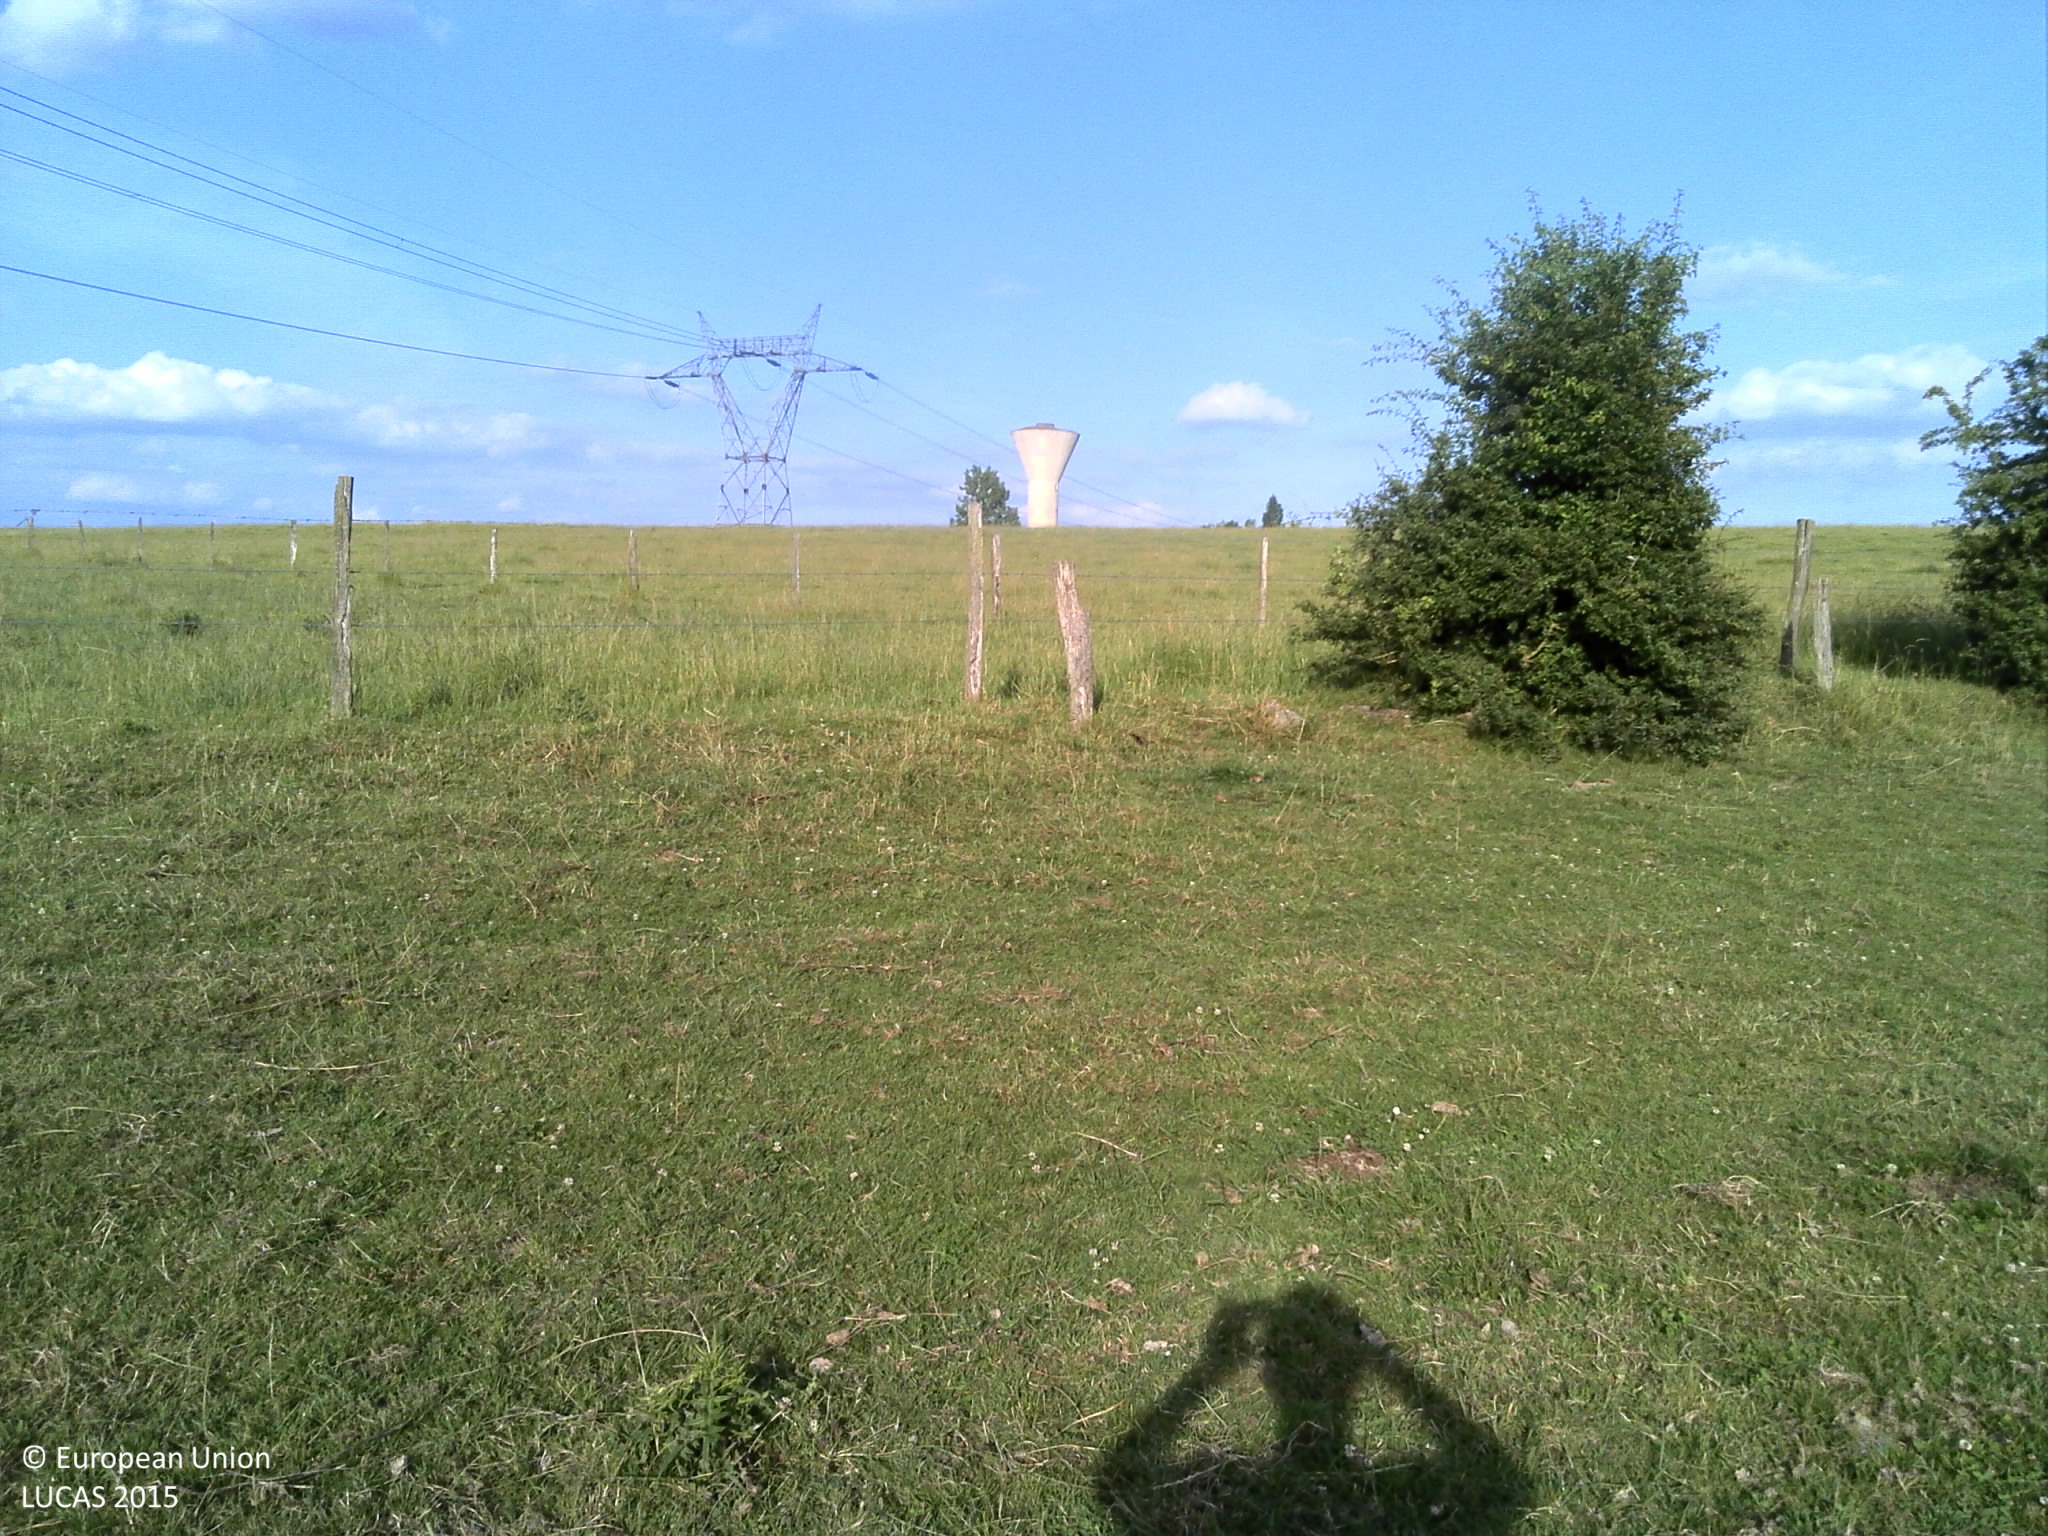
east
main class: Grassland
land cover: Grassland without tree/shrub cover
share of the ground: > 75 %
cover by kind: herbaceous plants 100 %
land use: Agriculture (excluding fallow land and kitchen gardens)
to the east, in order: Grassland without tree/shrub cover; Fences; Grass margins; Fences; Grassland without tree/shrub cover; Fences; Grassland without tree/shrub cover; Fences; Grass margins; Rape and turnip rape; Electric lines; Rape and turnip rape
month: June
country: FR
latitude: 49.1577
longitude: 6.4759
